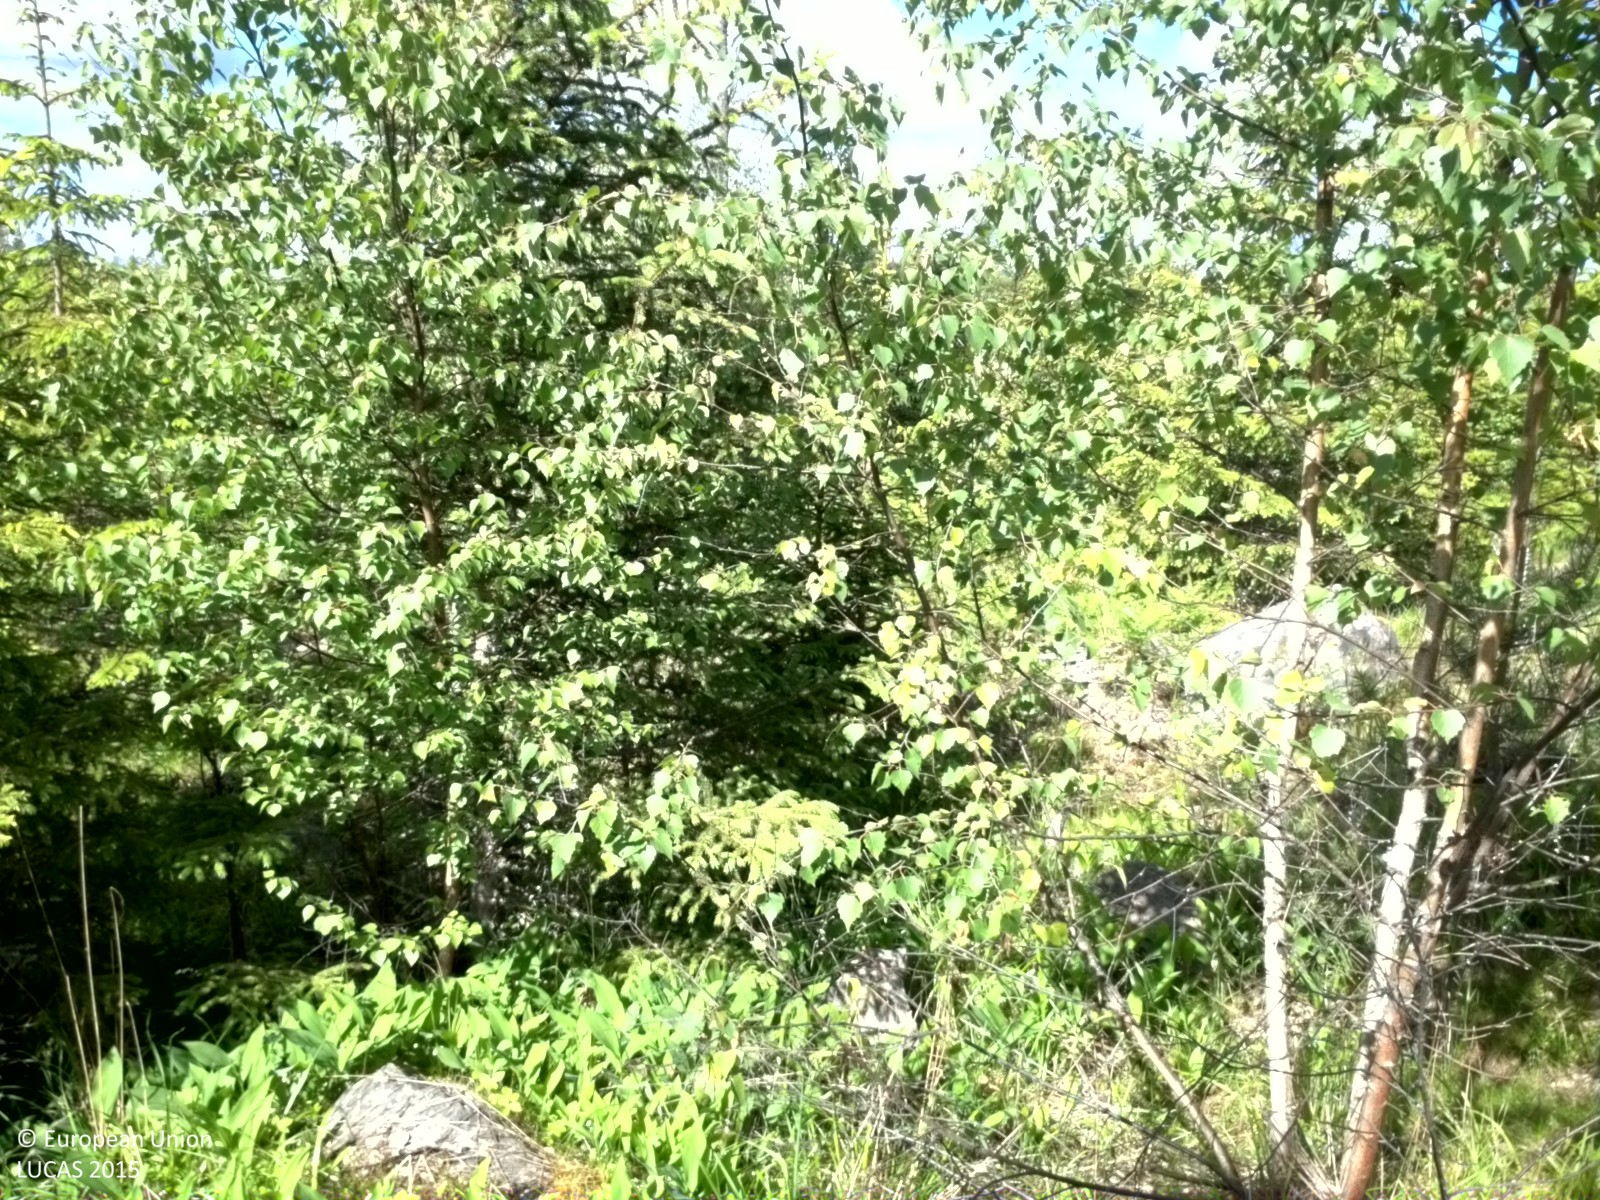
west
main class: Woodland
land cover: Spruce dominated mixed woodland
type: boreal forest
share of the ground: 50 - 75 %
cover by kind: broadleaved forest trees 30 %, coniferous forest trees 25 %, herbaceous plants 20 %, lichens and mosses 10 %, consolidated bare surface 10 %, shrubs 5 %
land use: Forestry
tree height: < 5 m
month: June
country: SE
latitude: 60.1500
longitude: 17.7204
